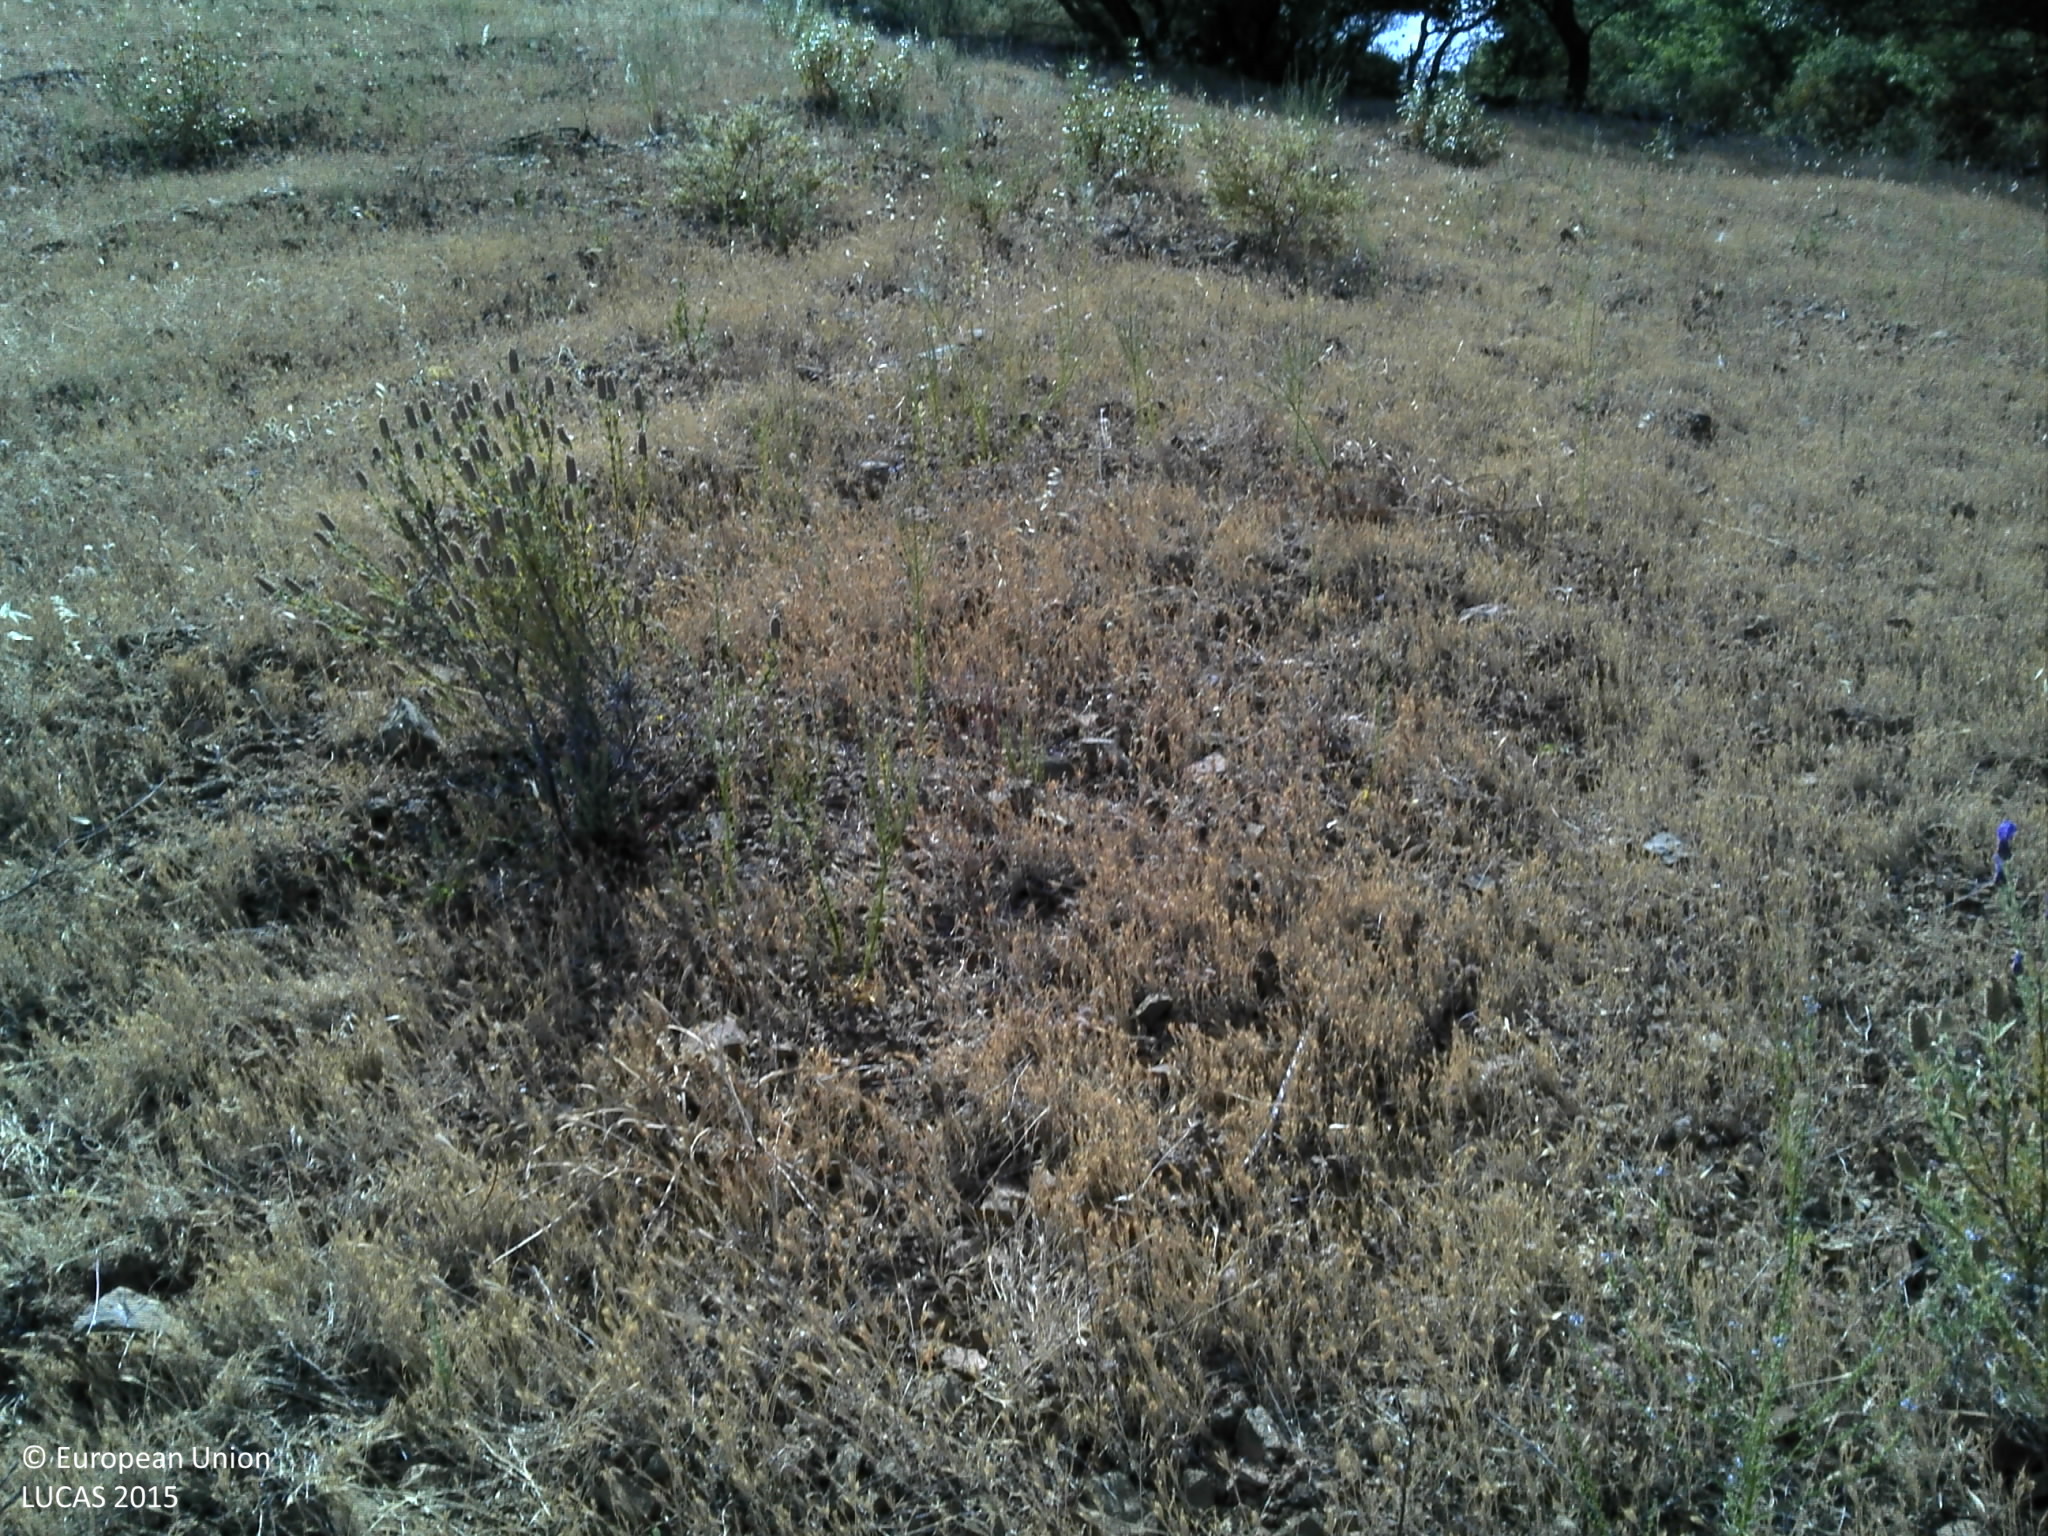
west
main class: Grassland
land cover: Grassland with sparse tree/shrub cover
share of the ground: 50 - 75 %
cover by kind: herbaceous plants 70 %, unconsolidated bare surface 25 %, broadleaved forest trees 5 %
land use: Agriculture (excluding fallow land and kitchen gardens)
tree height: > 5 m
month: May
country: PT
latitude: 37.2852
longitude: -7.4529
